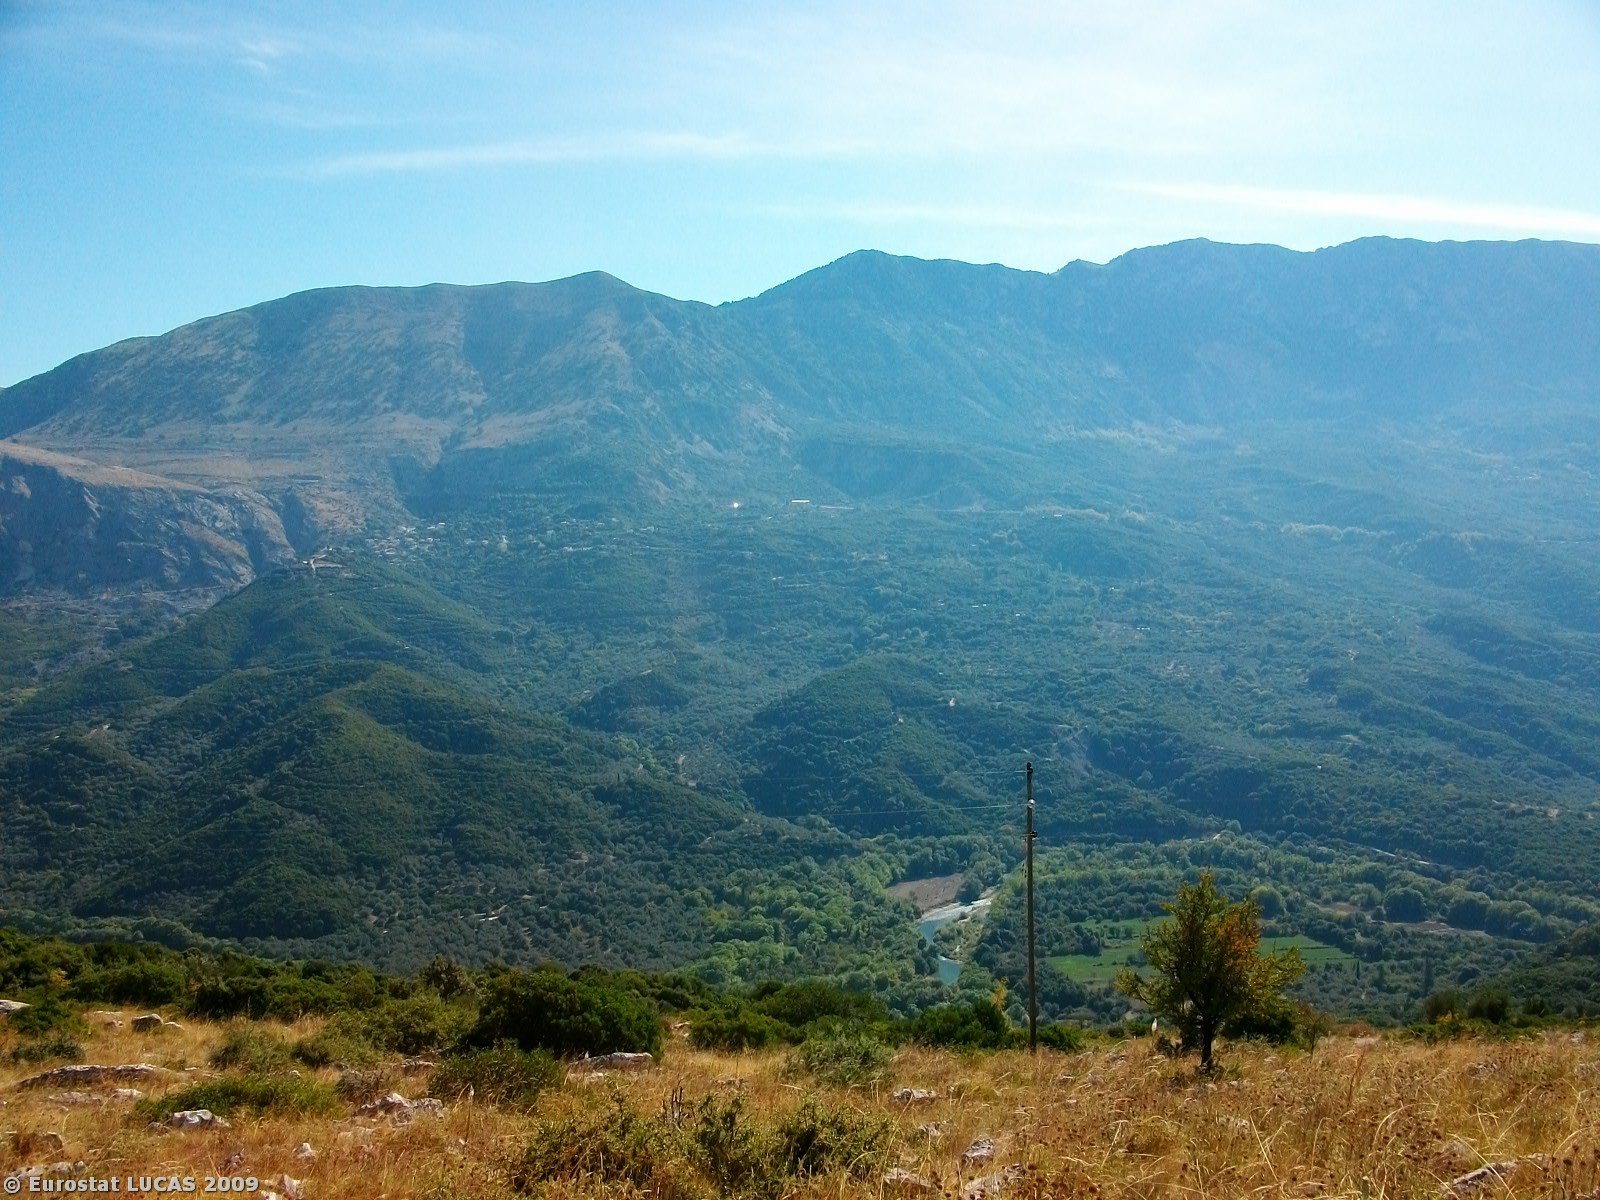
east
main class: Grassland
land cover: Grassland with sparse tree/shrub cover
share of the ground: 50 - 75 %
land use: Agriculture (excluding fallow land and kitchen gardens)
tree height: < 5 m
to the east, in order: Grassland with sparse tree/shrub cover; Electric lines; Grassland with sparse tree/shrub cover; Shrubland without tree cover; Grass margins; Paved roads, cycling and walking lanes; Grass margins; Shrubland without tree cover; Rivers and streams; Shrubland without tree cover
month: September
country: GR
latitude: 39.5809
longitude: 20.4420
